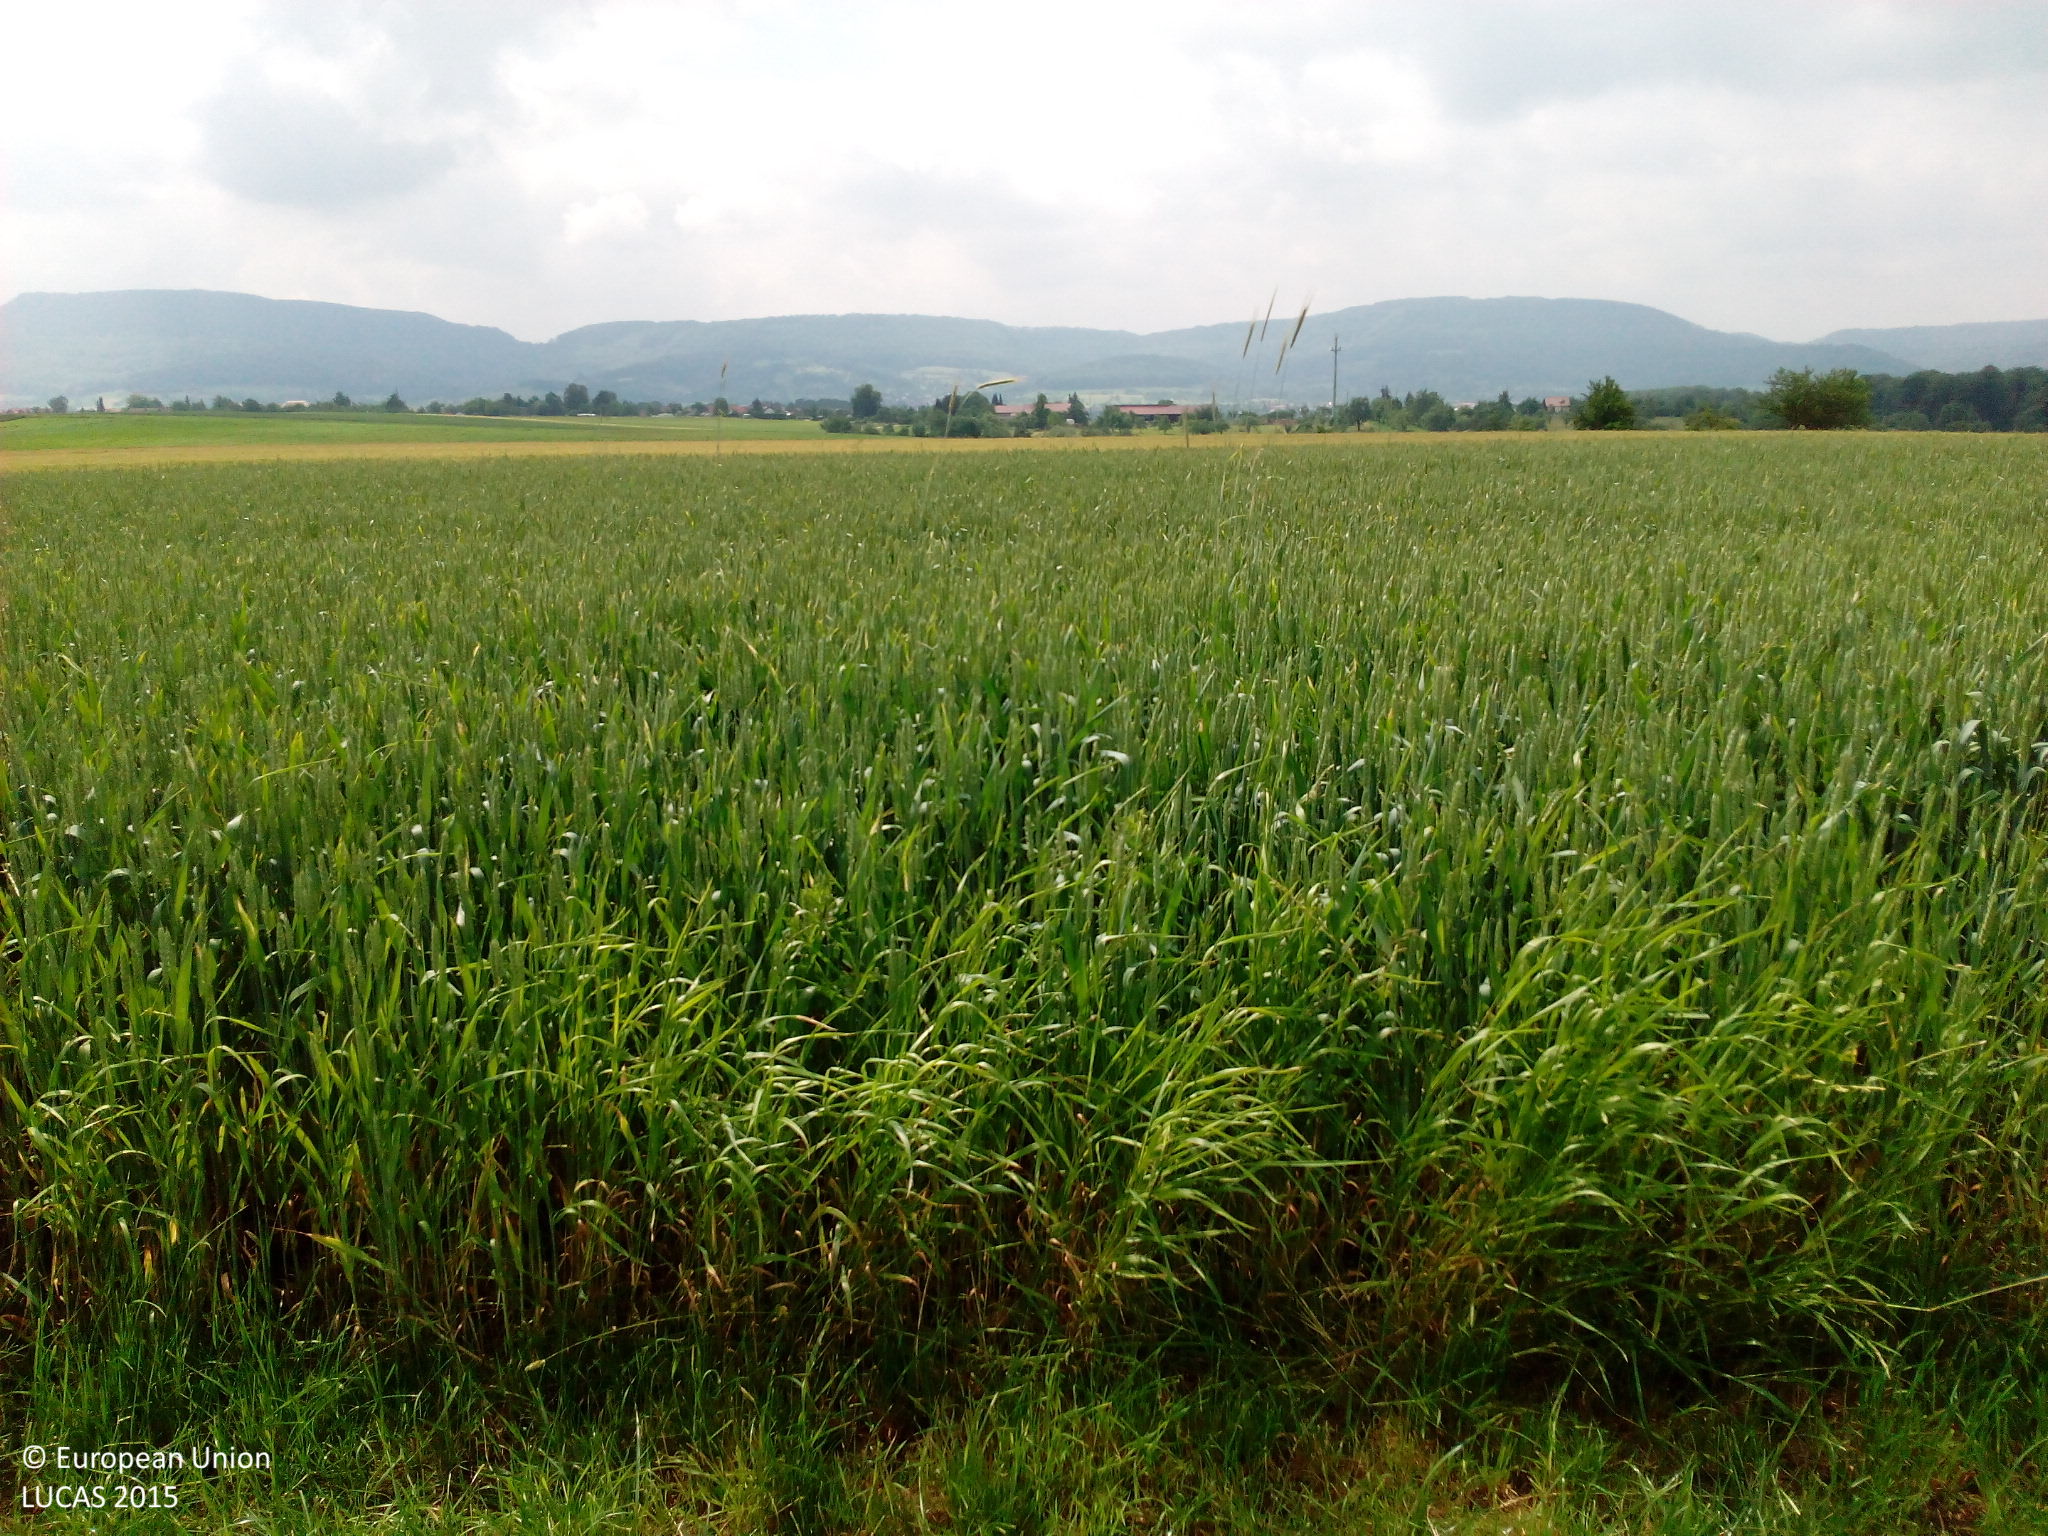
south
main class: Grassland
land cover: Grassland without tree/shrub cover
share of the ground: > 75 %
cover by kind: herbaceous plants 100 %
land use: Agriculture (excluding fallow land and kitchen gardens)
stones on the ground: < 10 %
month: June
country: DE
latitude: 48.6728
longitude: 9.6335
